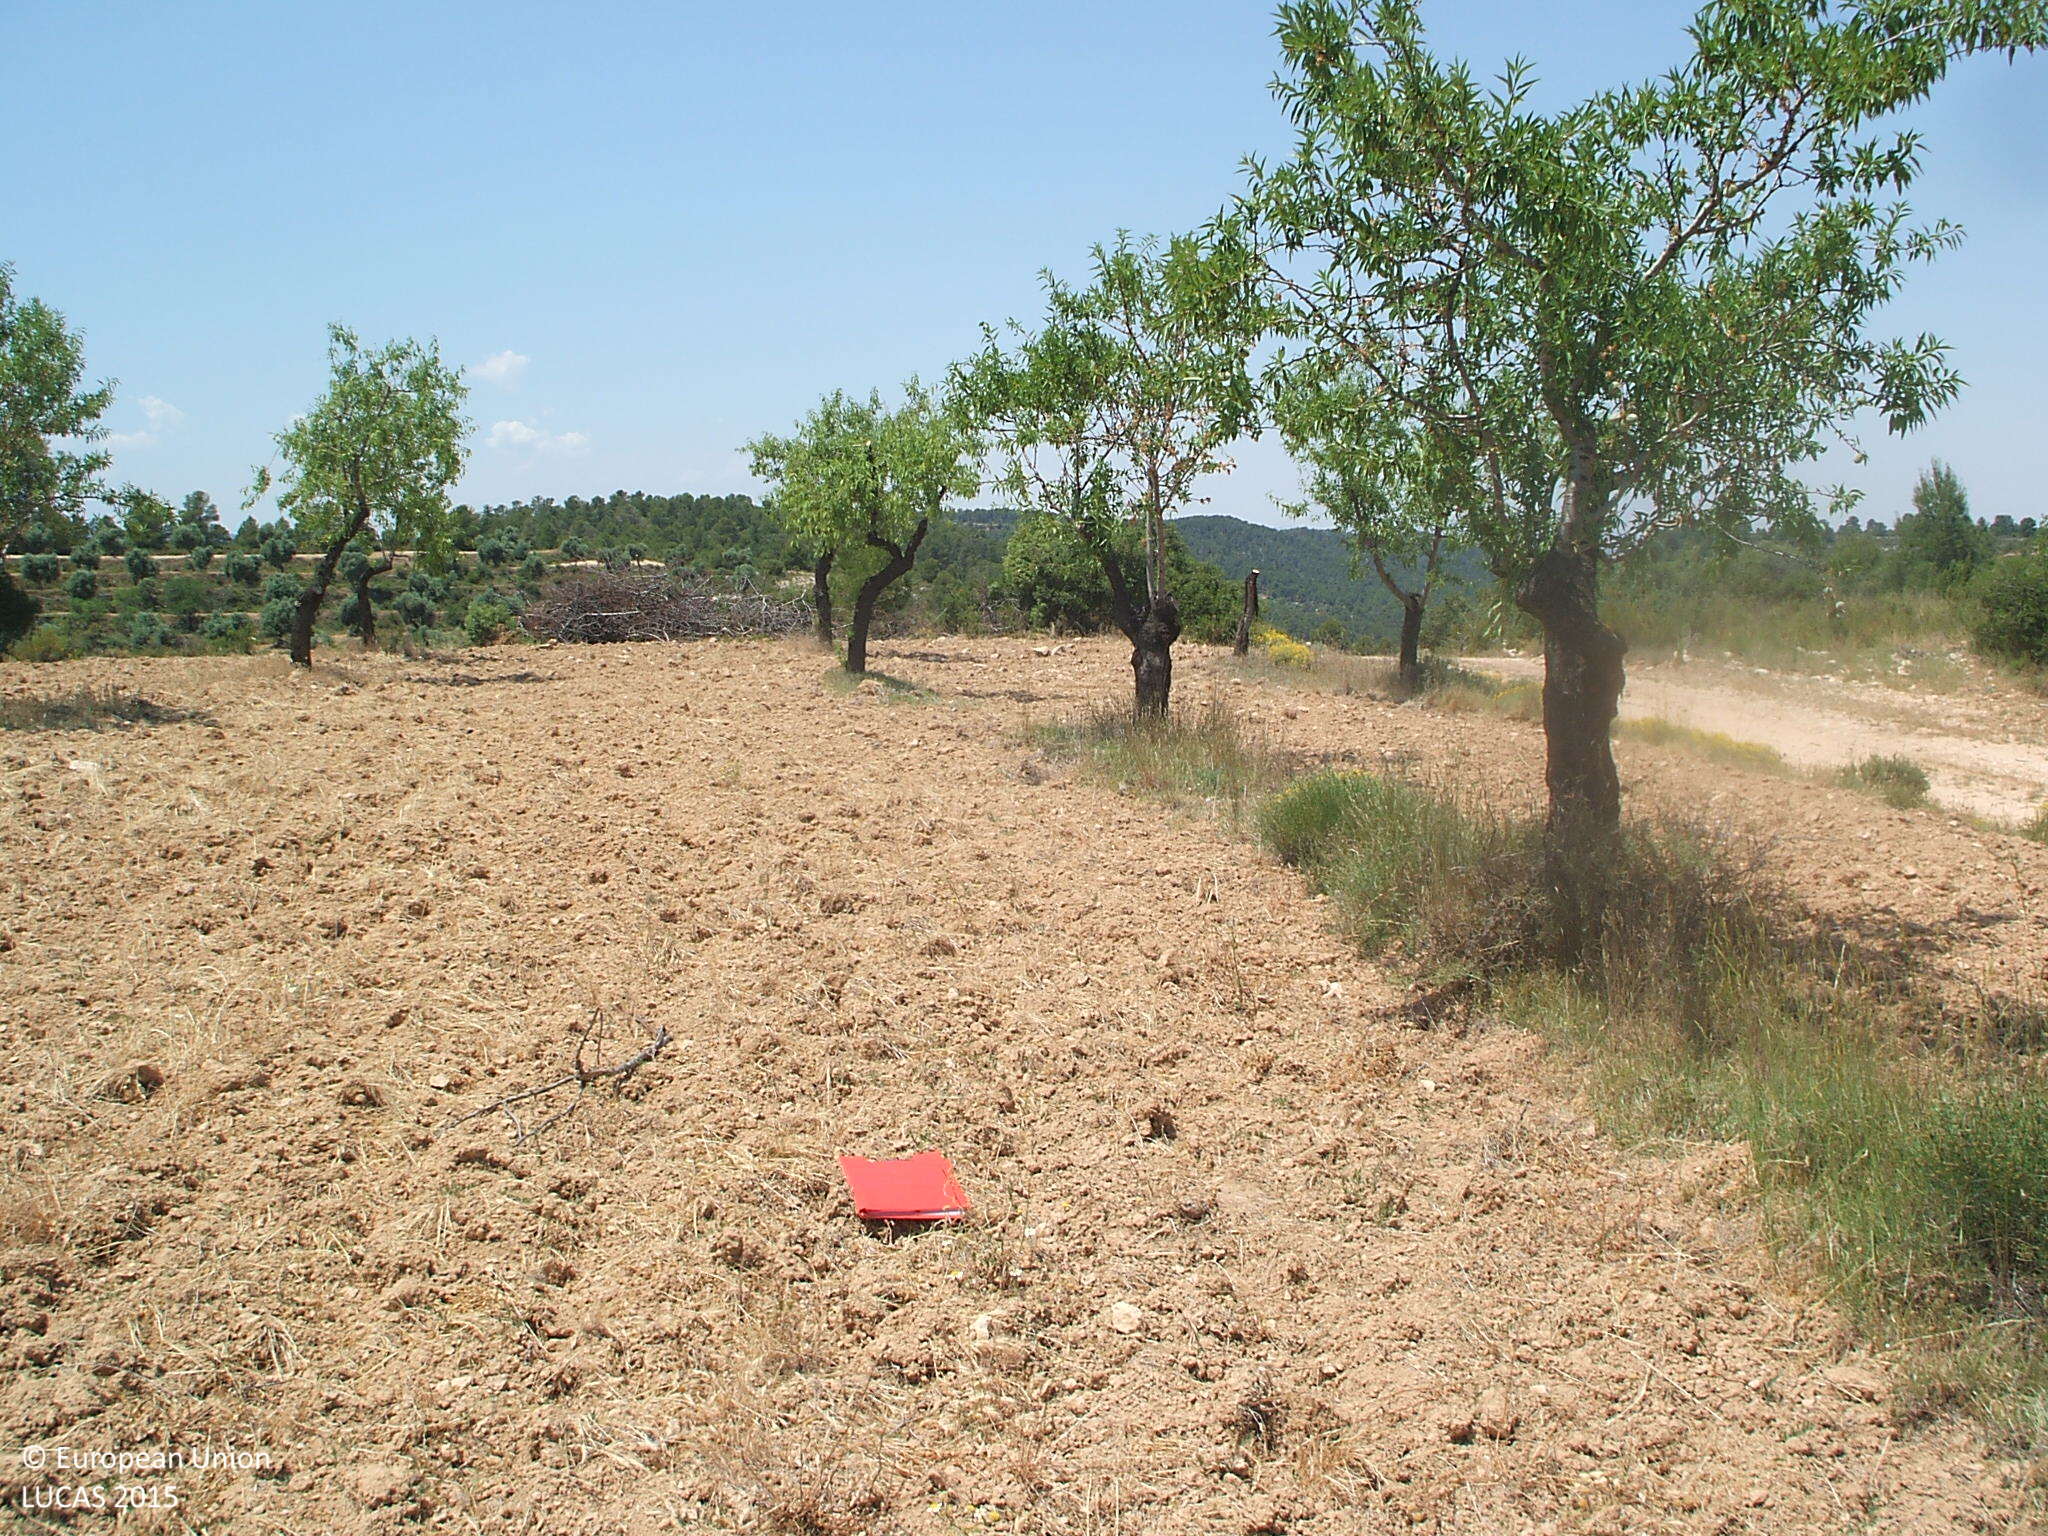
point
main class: Cropland
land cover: Nuts trees
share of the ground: 10 - 25 %
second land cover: Other bare soil
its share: > 75 %
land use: Agriculture (excluding fallow land and kitchen gardens)
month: June
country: ES
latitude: 40.9271
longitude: -0.1162
